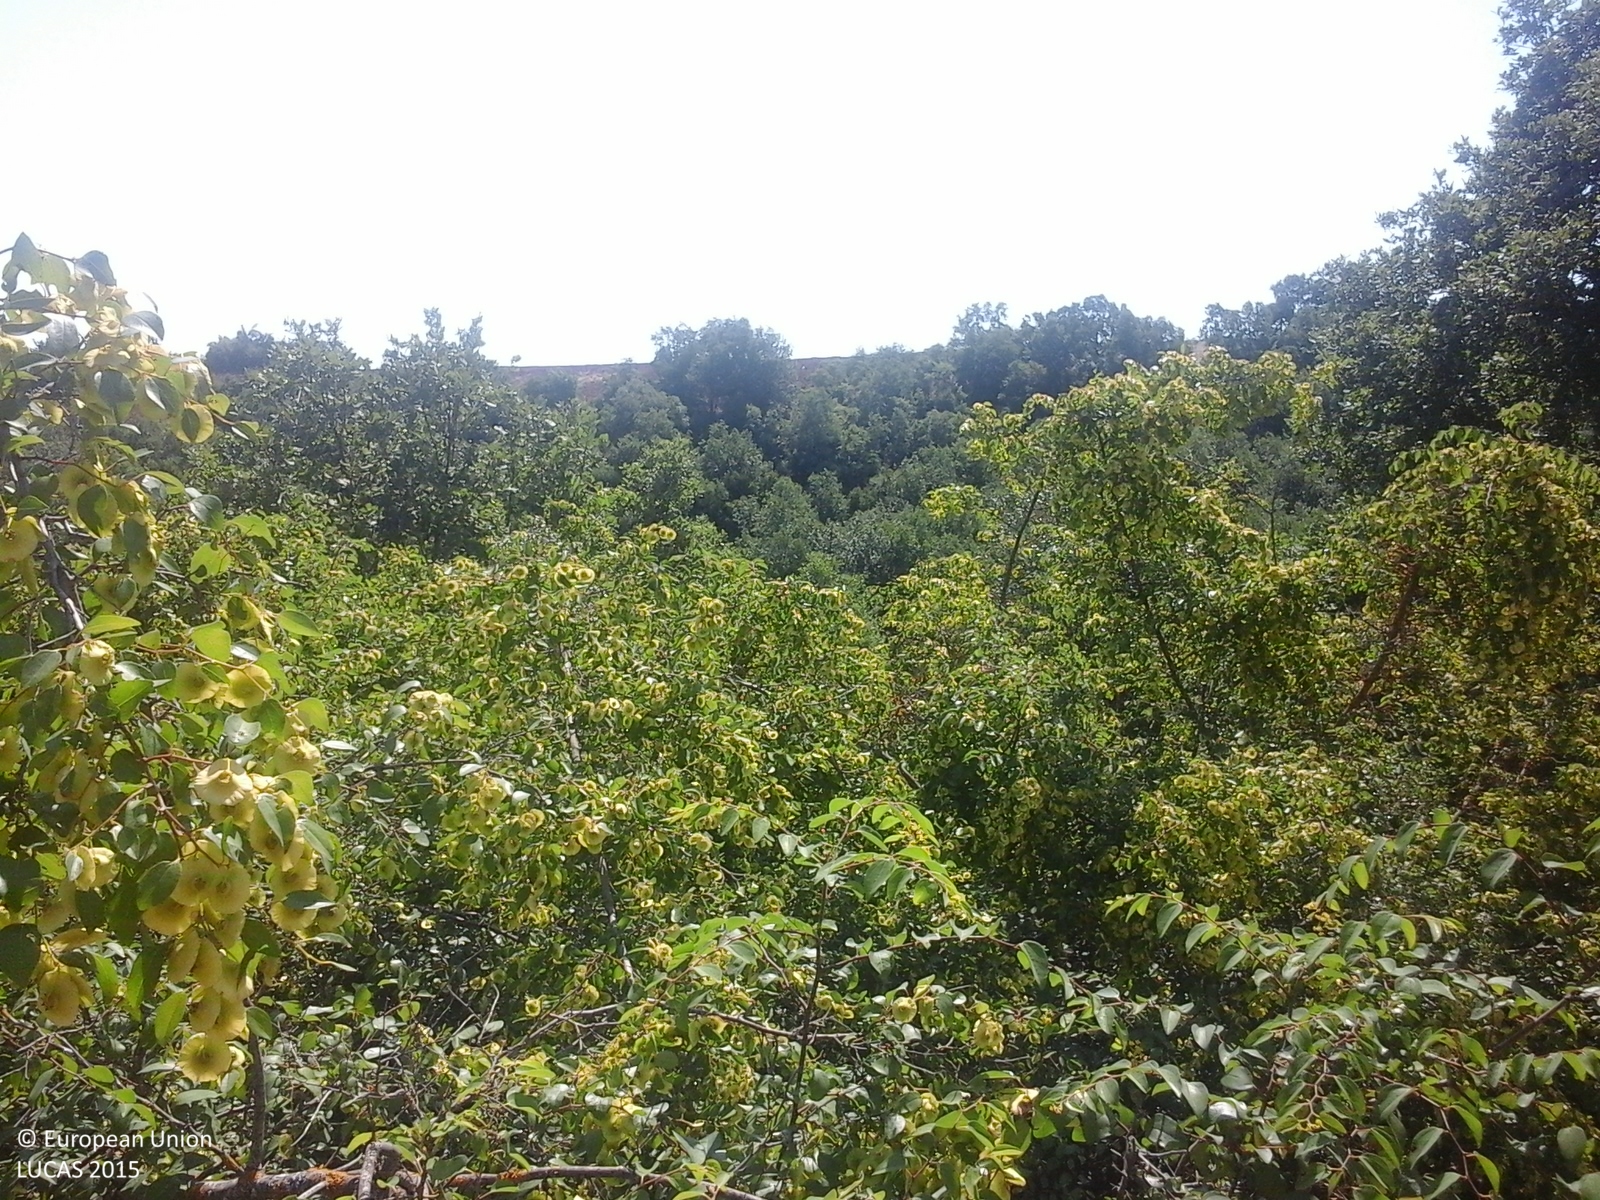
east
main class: Shrubland
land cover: Shrubland without tree cover
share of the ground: > 75 %
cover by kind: shrubs 75 %, herbaceous plants 25 %
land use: Semi-natural and natural areas not in use
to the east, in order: Shrubland without tree cover; Broadleaved woodland; Tracks; Other bare soil; Grassland without tree/shrub cover
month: July
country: GR
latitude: 40.6171
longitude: 23.1895
